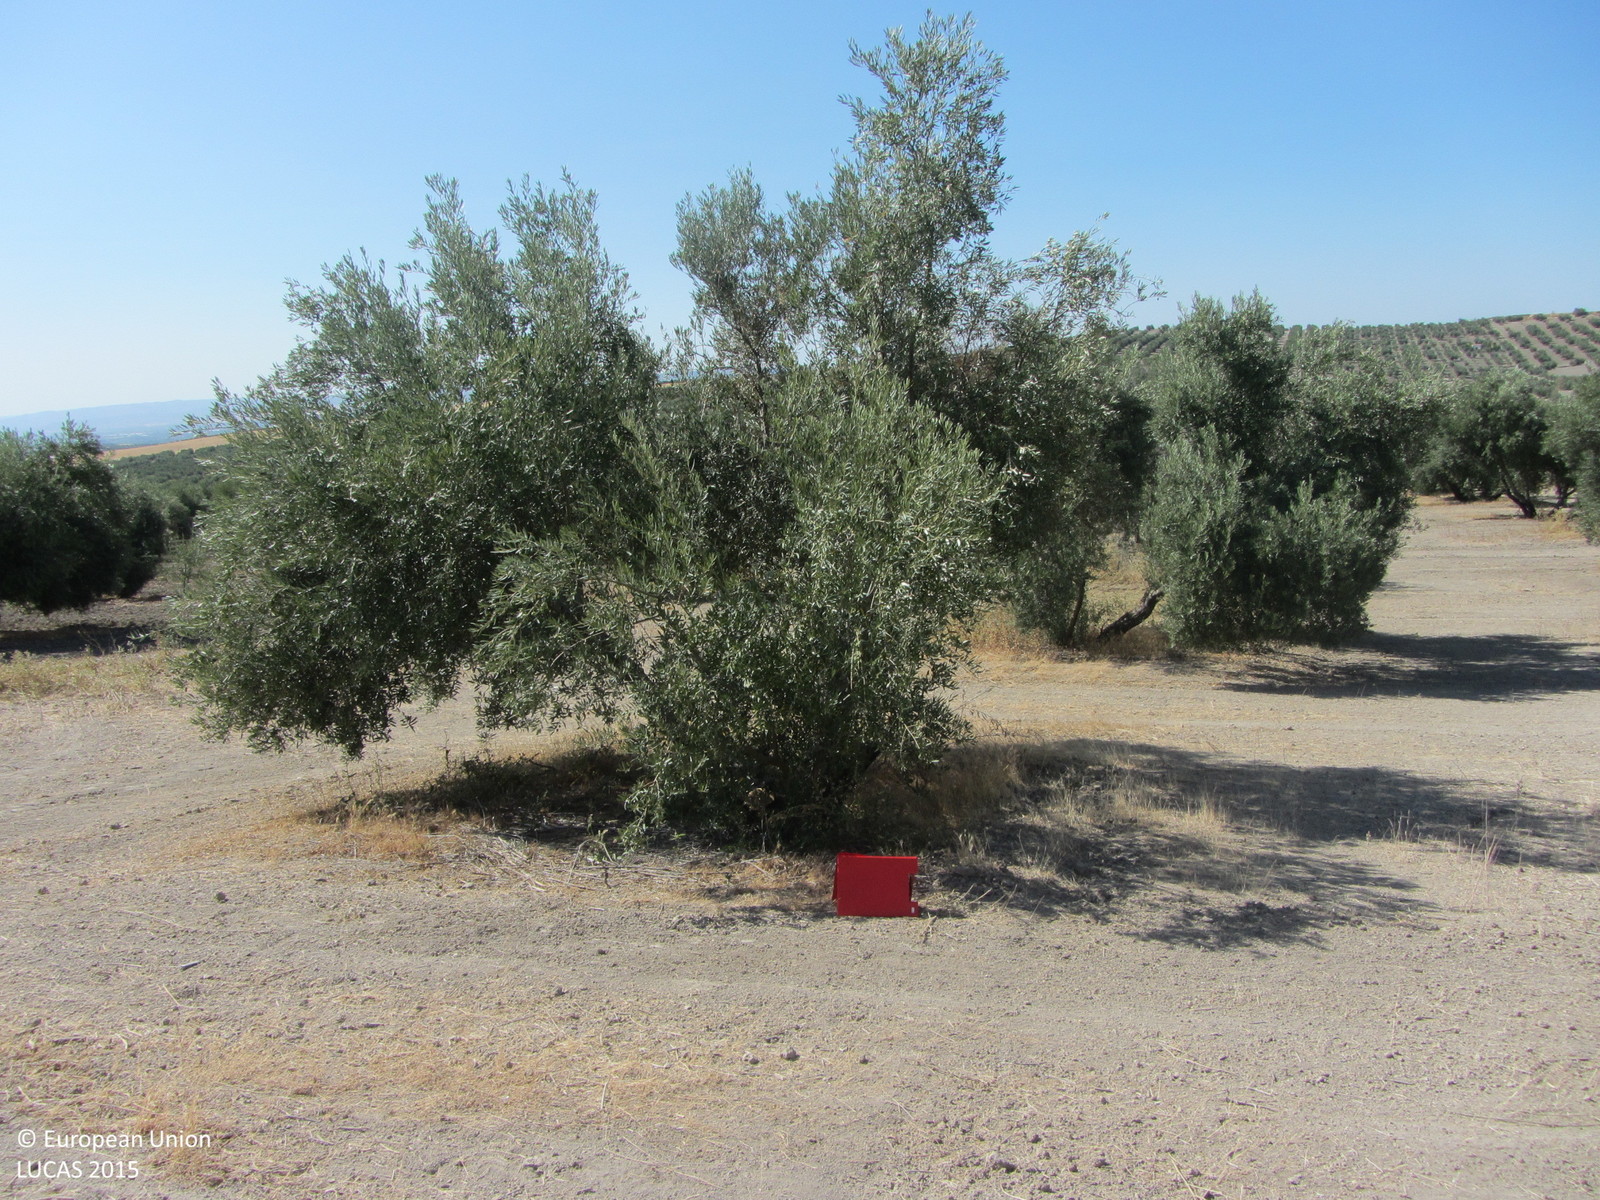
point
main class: Cropland
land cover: Olive groves
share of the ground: 25 - 50 %
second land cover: Other bare soil
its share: > 75 %
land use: Agriculture (excluding fallow land and kitchen gardens)
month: July
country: ES
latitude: 37.9761
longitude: -3.8592
